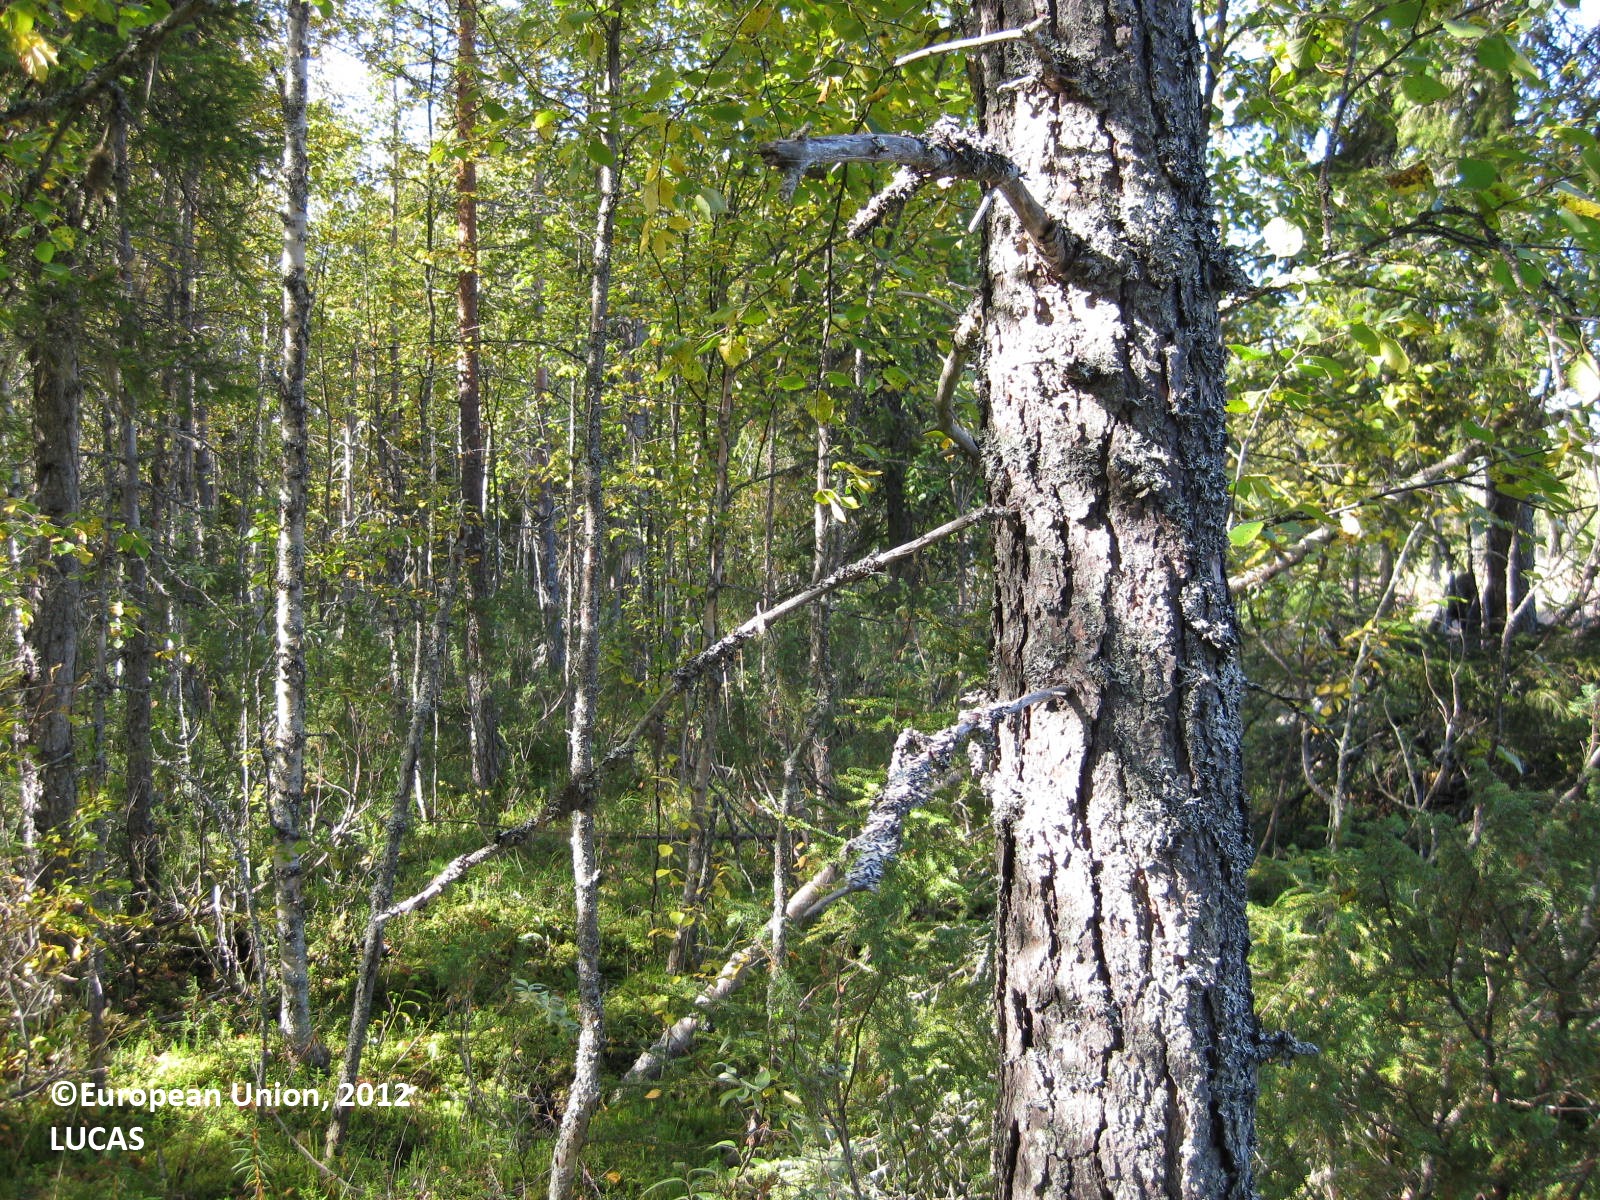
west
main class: Woodland
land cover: Other mixed woodland
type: boreal forest
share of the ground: > 75 %
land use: Forestry
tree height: > 5 m
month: August
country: FI
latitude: 65.9111
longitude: 28.6708
